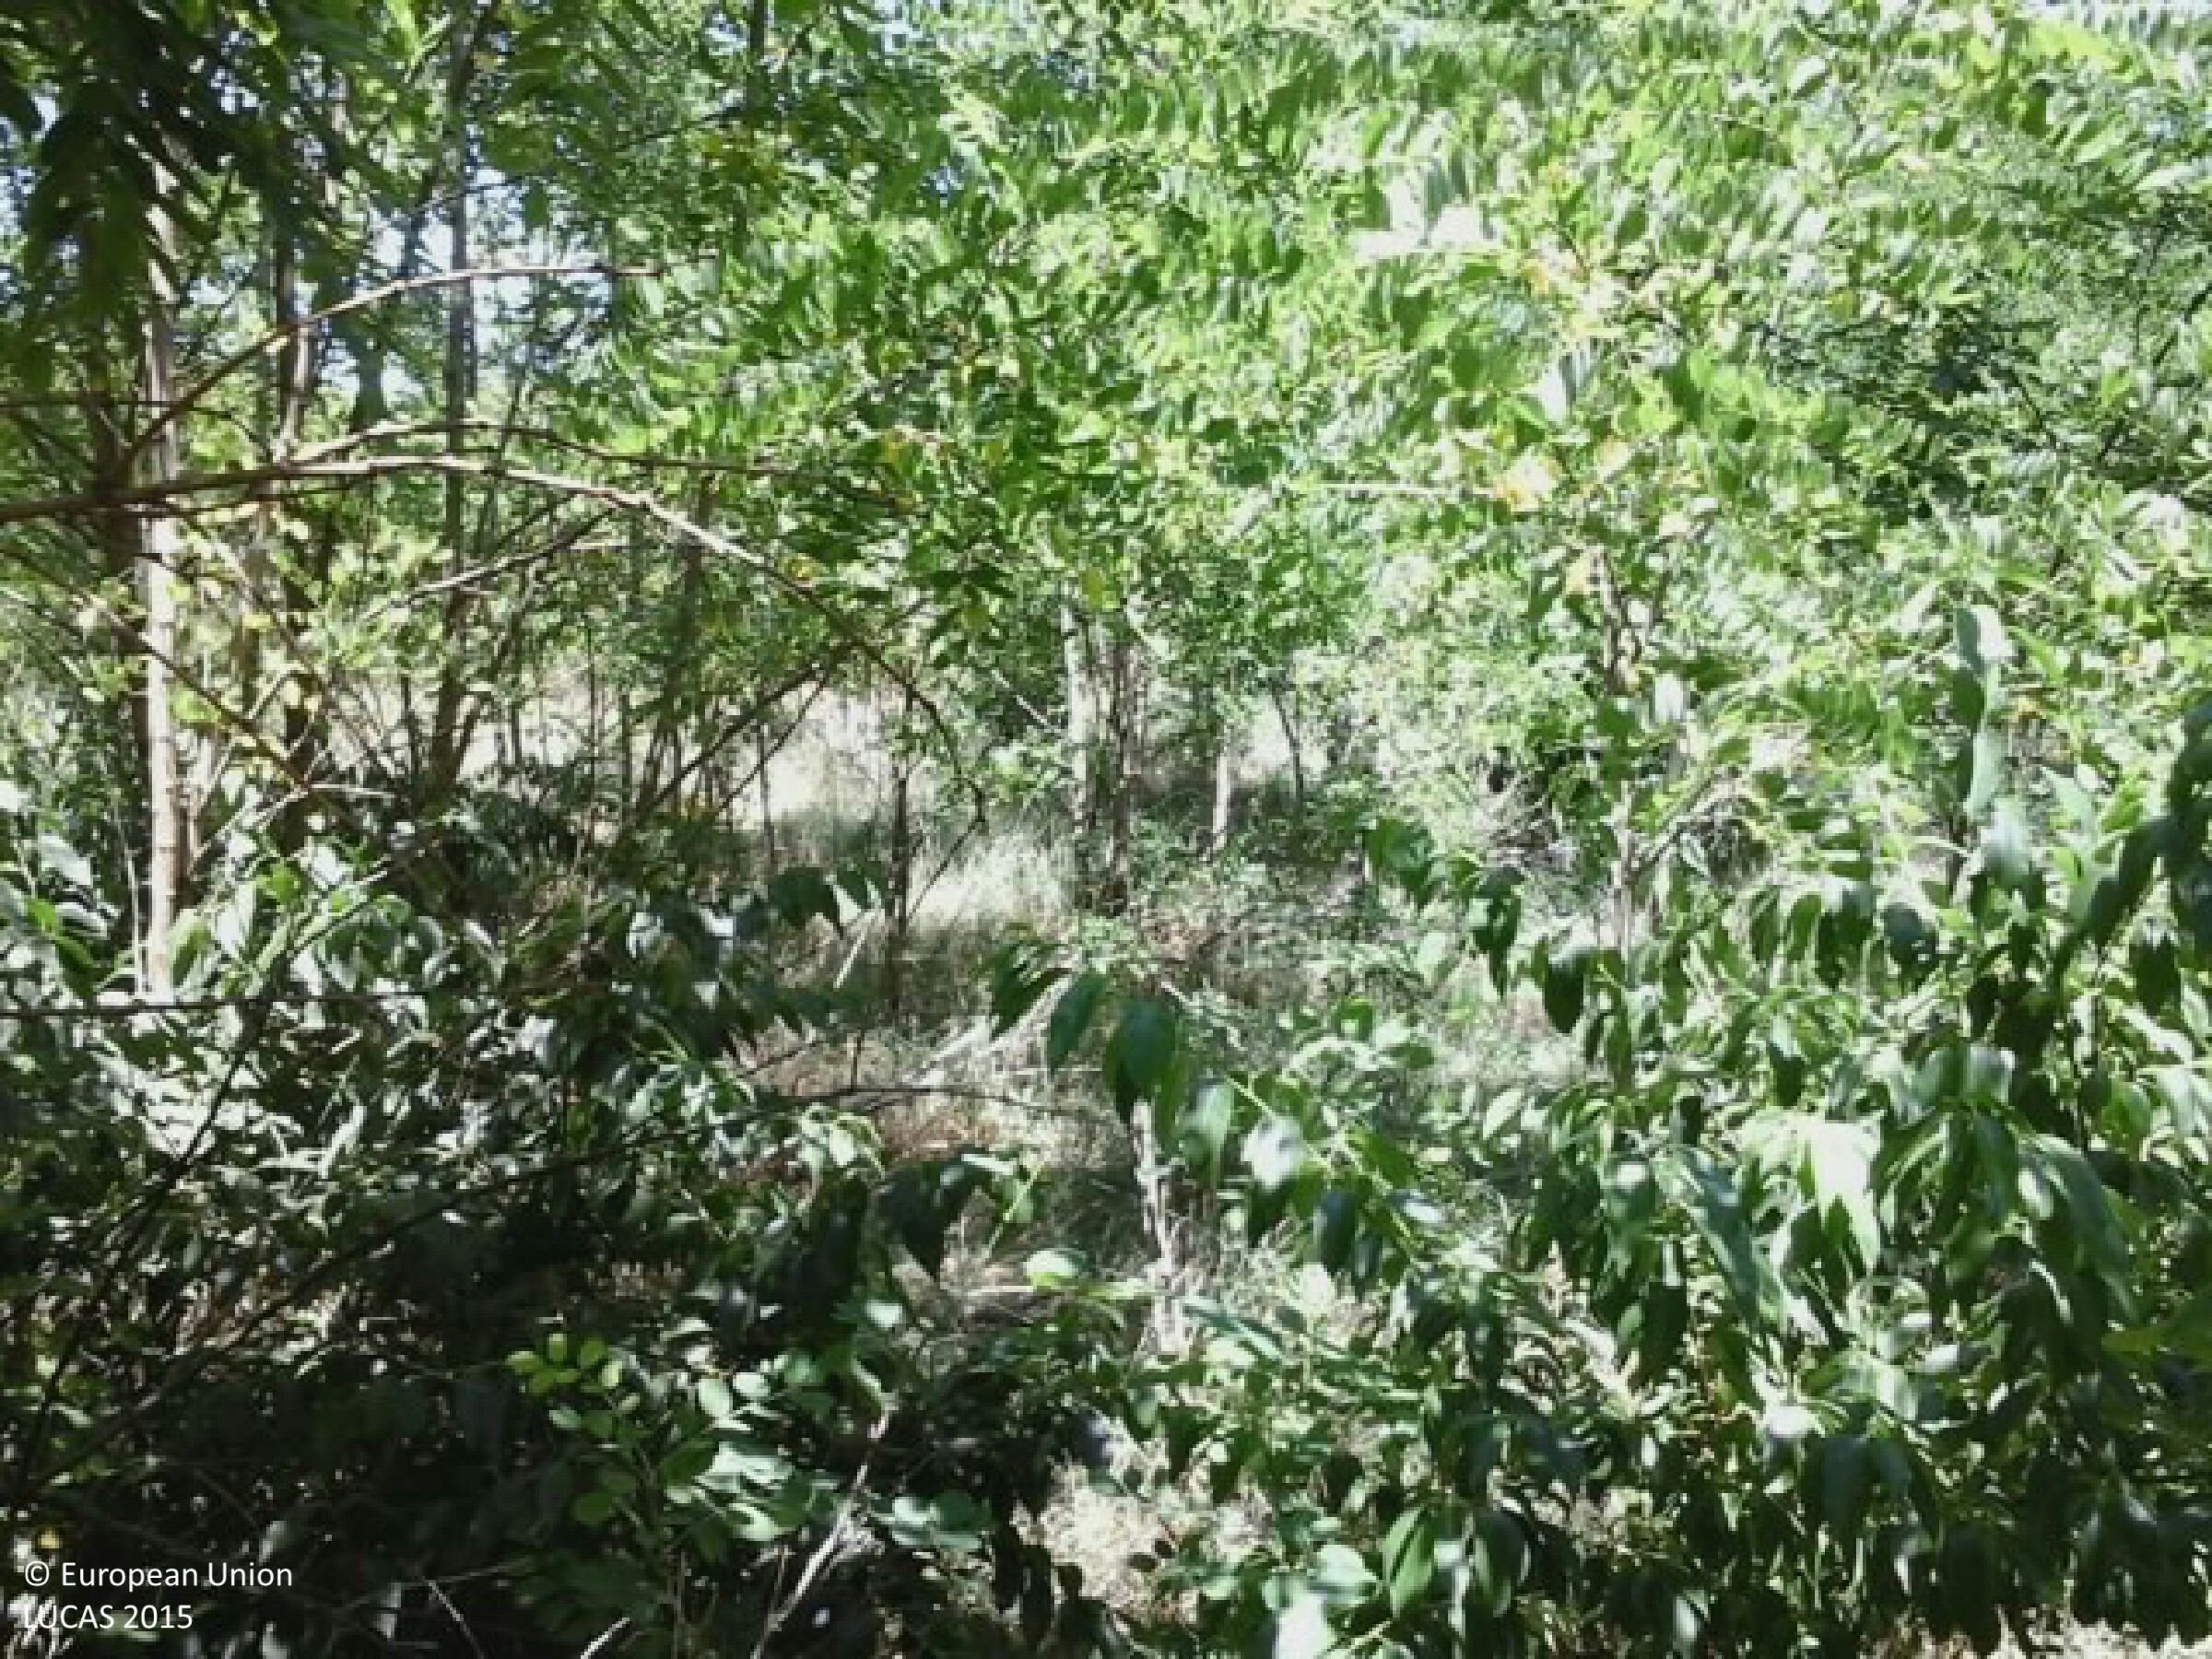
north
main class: Woodland
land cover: Broadleaved woodland
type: mesophytic deciduous forest
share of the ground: > 75 %
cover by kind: broadleaved forest trees 95 %, herbaceous plants 5 %
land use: Forestry
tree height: < 5 m
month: July
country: HU
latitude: 47.3275
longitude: 19.2414
